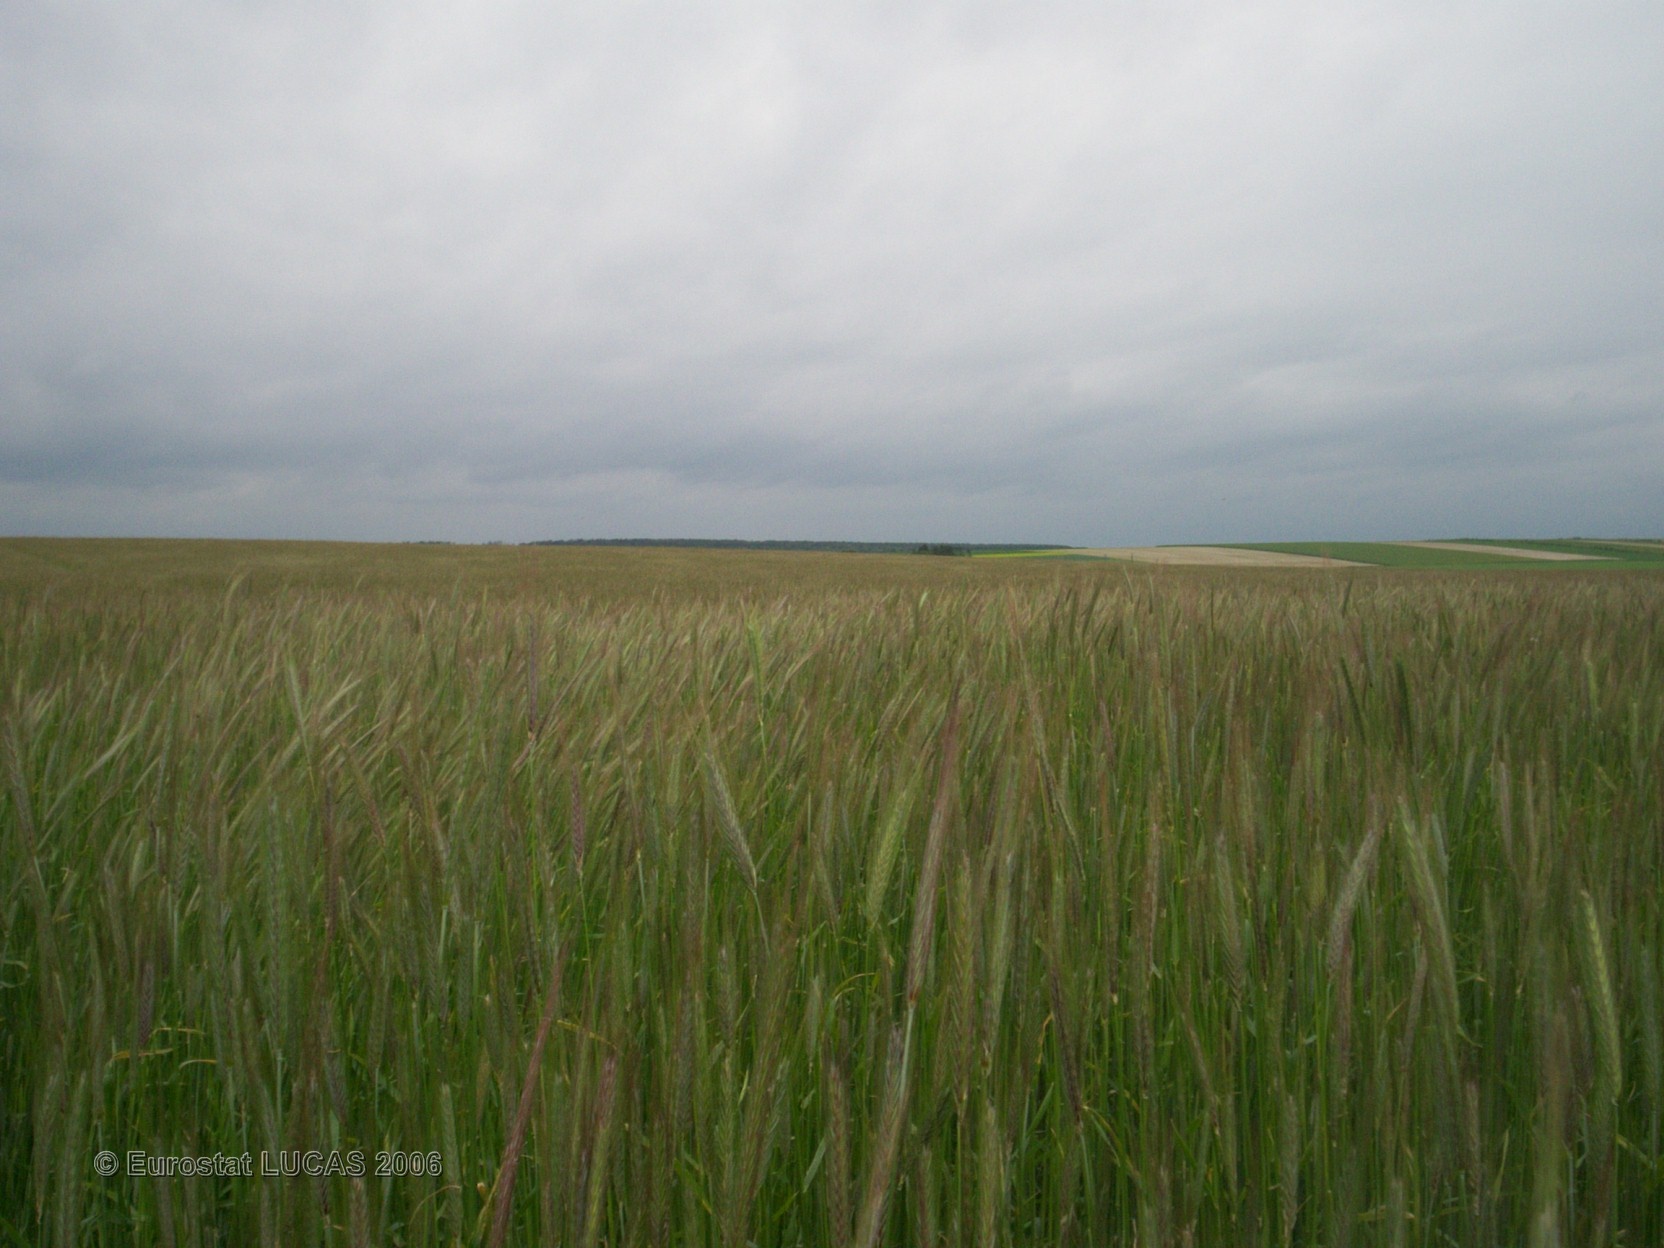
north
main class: Cropland
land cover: Rye
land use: Agriculture (excluding fallow land and kitchen gardens)
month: May
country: FR
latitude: 49.3405
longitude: 4.3392
